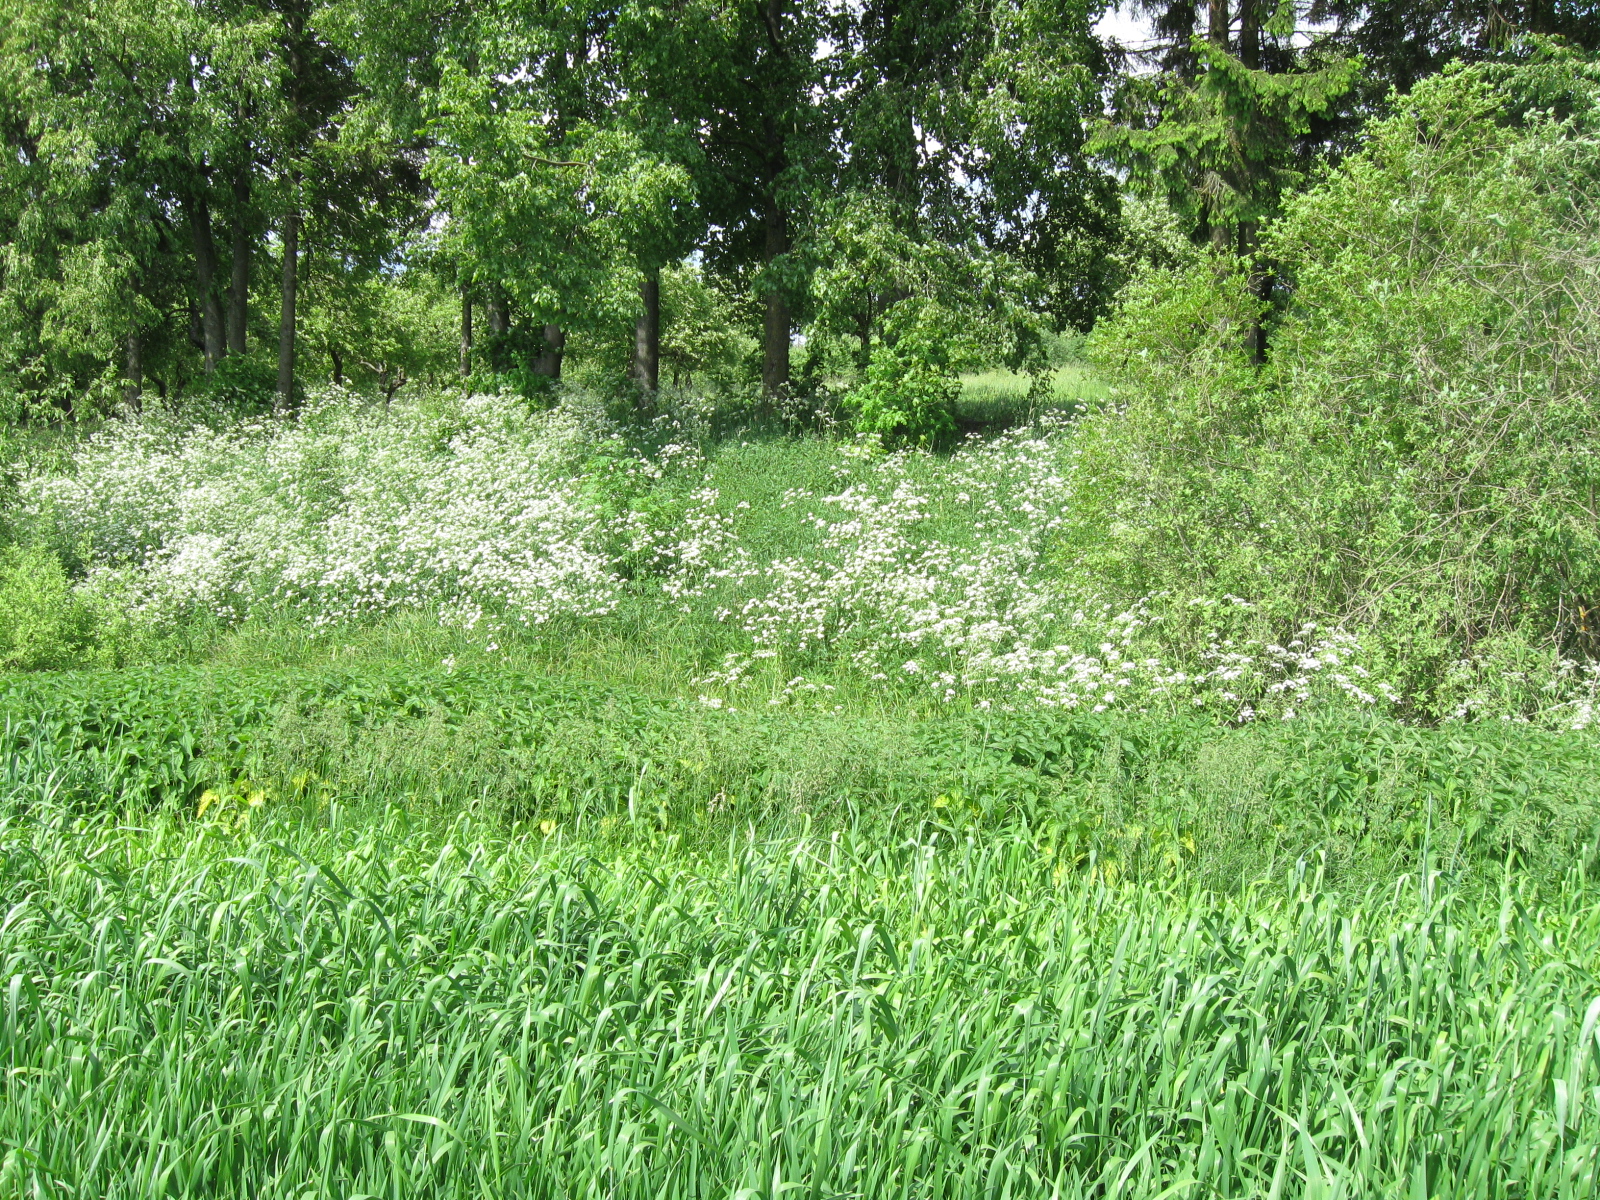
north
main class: Cropland
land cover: Common wheat
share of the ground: > 75 %
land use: Agriculture (excluding fallow land and kitchen gardens)
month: June
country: LT
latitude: 54.3419
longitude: 23.7935
